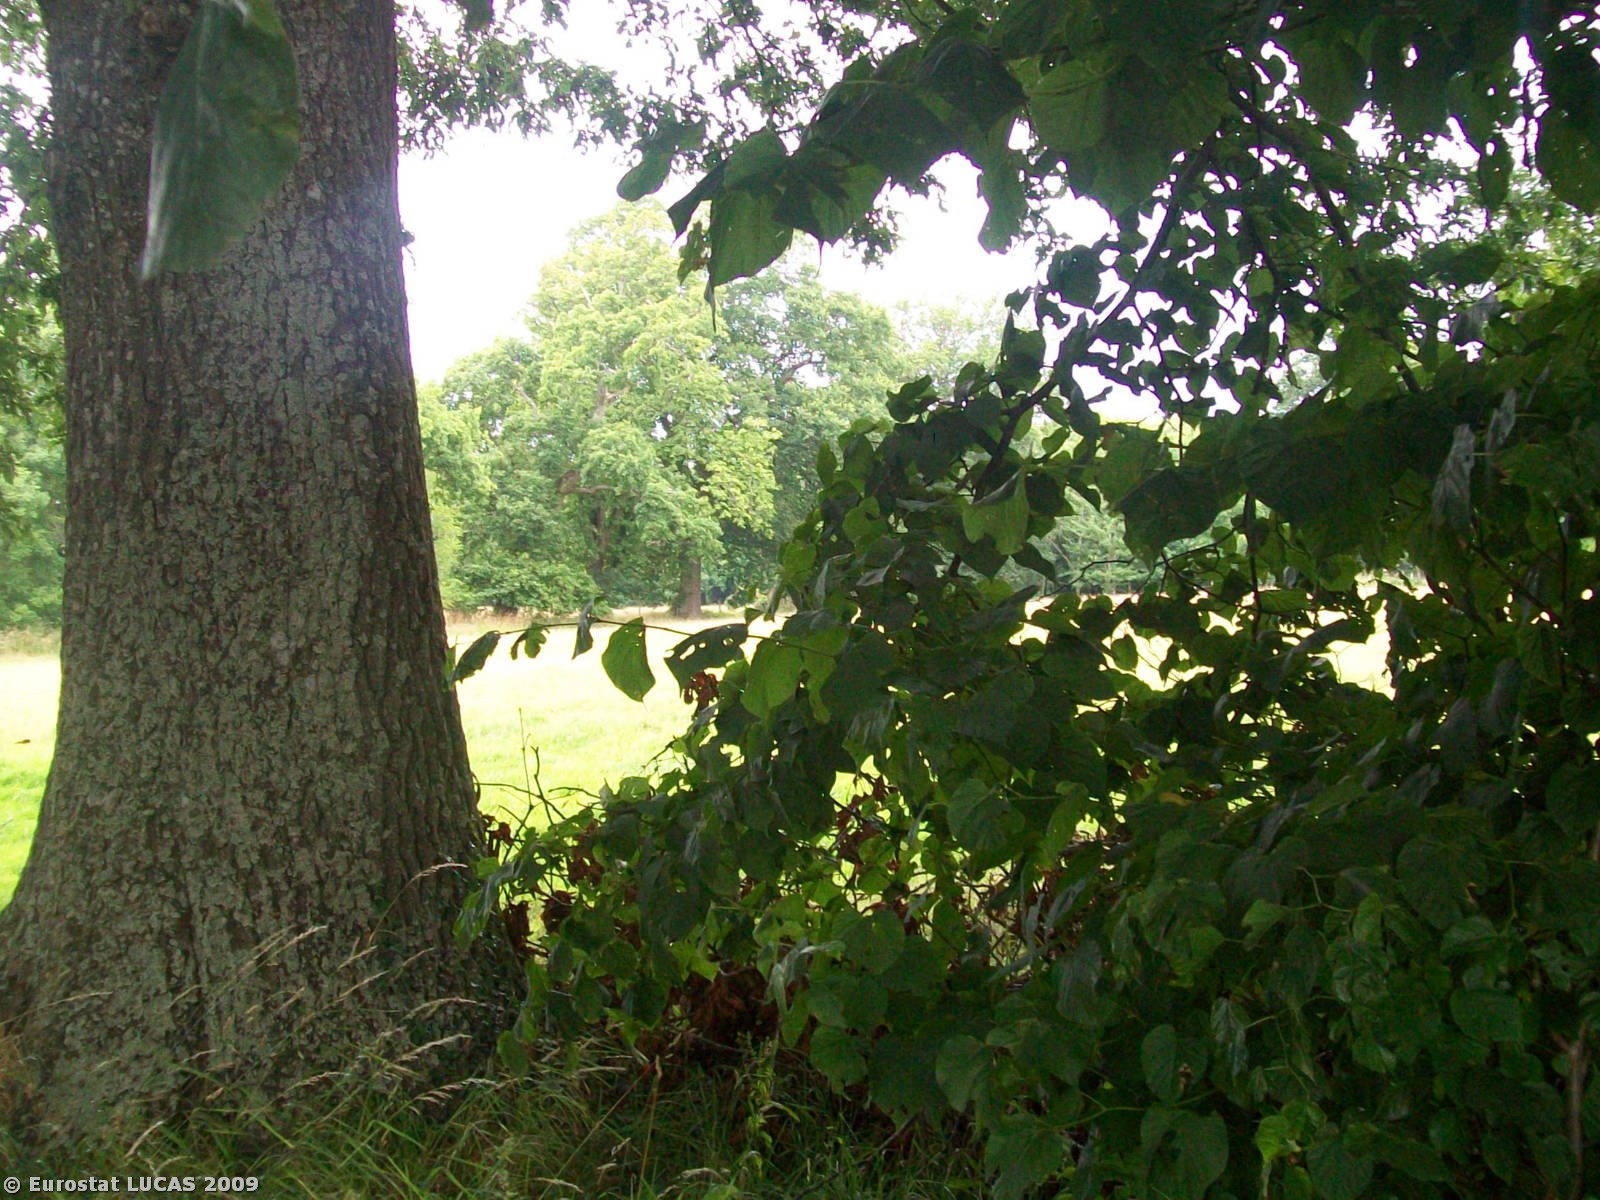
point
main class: Grassland
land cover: Grassland without tree/shrub cover
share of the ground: > 75 %
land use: Agriculture (excluding fallow land and kitchen gardens)
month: July
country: GB
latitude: 50.7384
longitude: -2.0898
